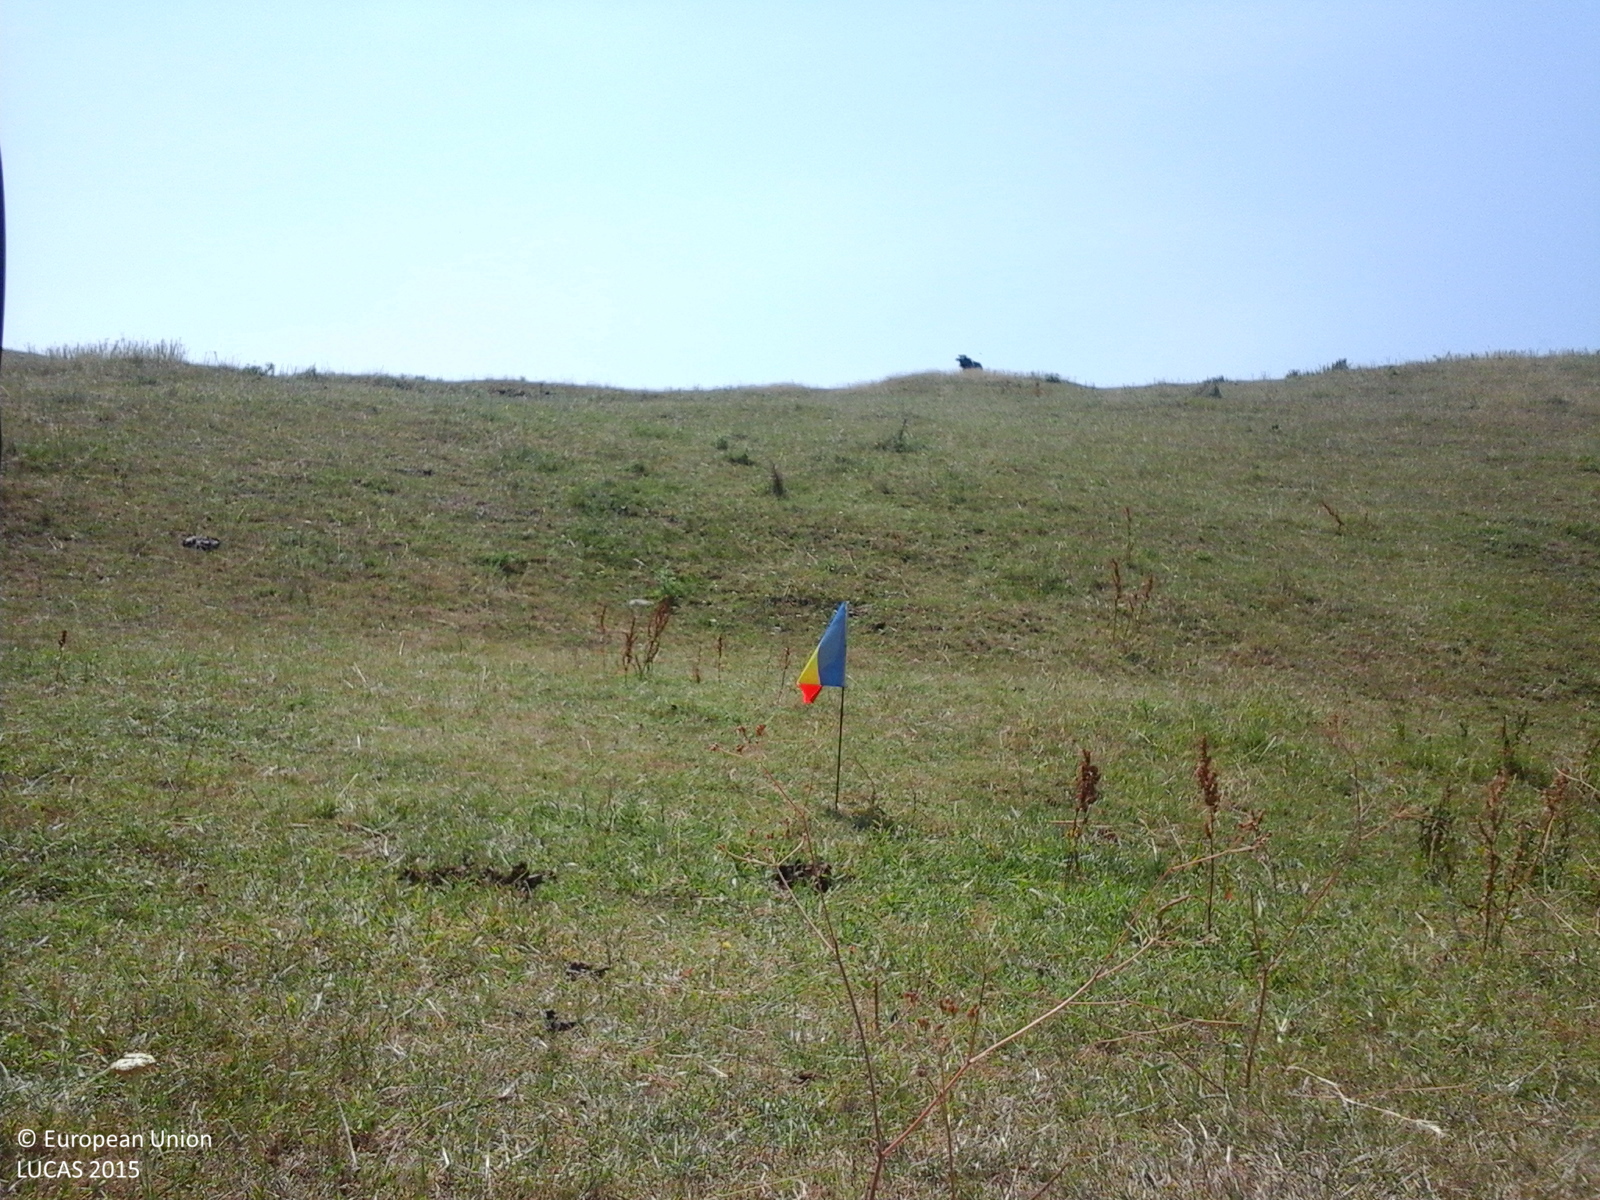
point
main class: Grassland
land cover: Grassland without tree/shrub cover
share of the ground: > 75 %
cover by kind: herbaceous plants 100 %
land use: Agriculture (excluding fallow land and kitchen gardens)
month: June
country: RO
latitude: 46.9358
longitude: 27.8446
